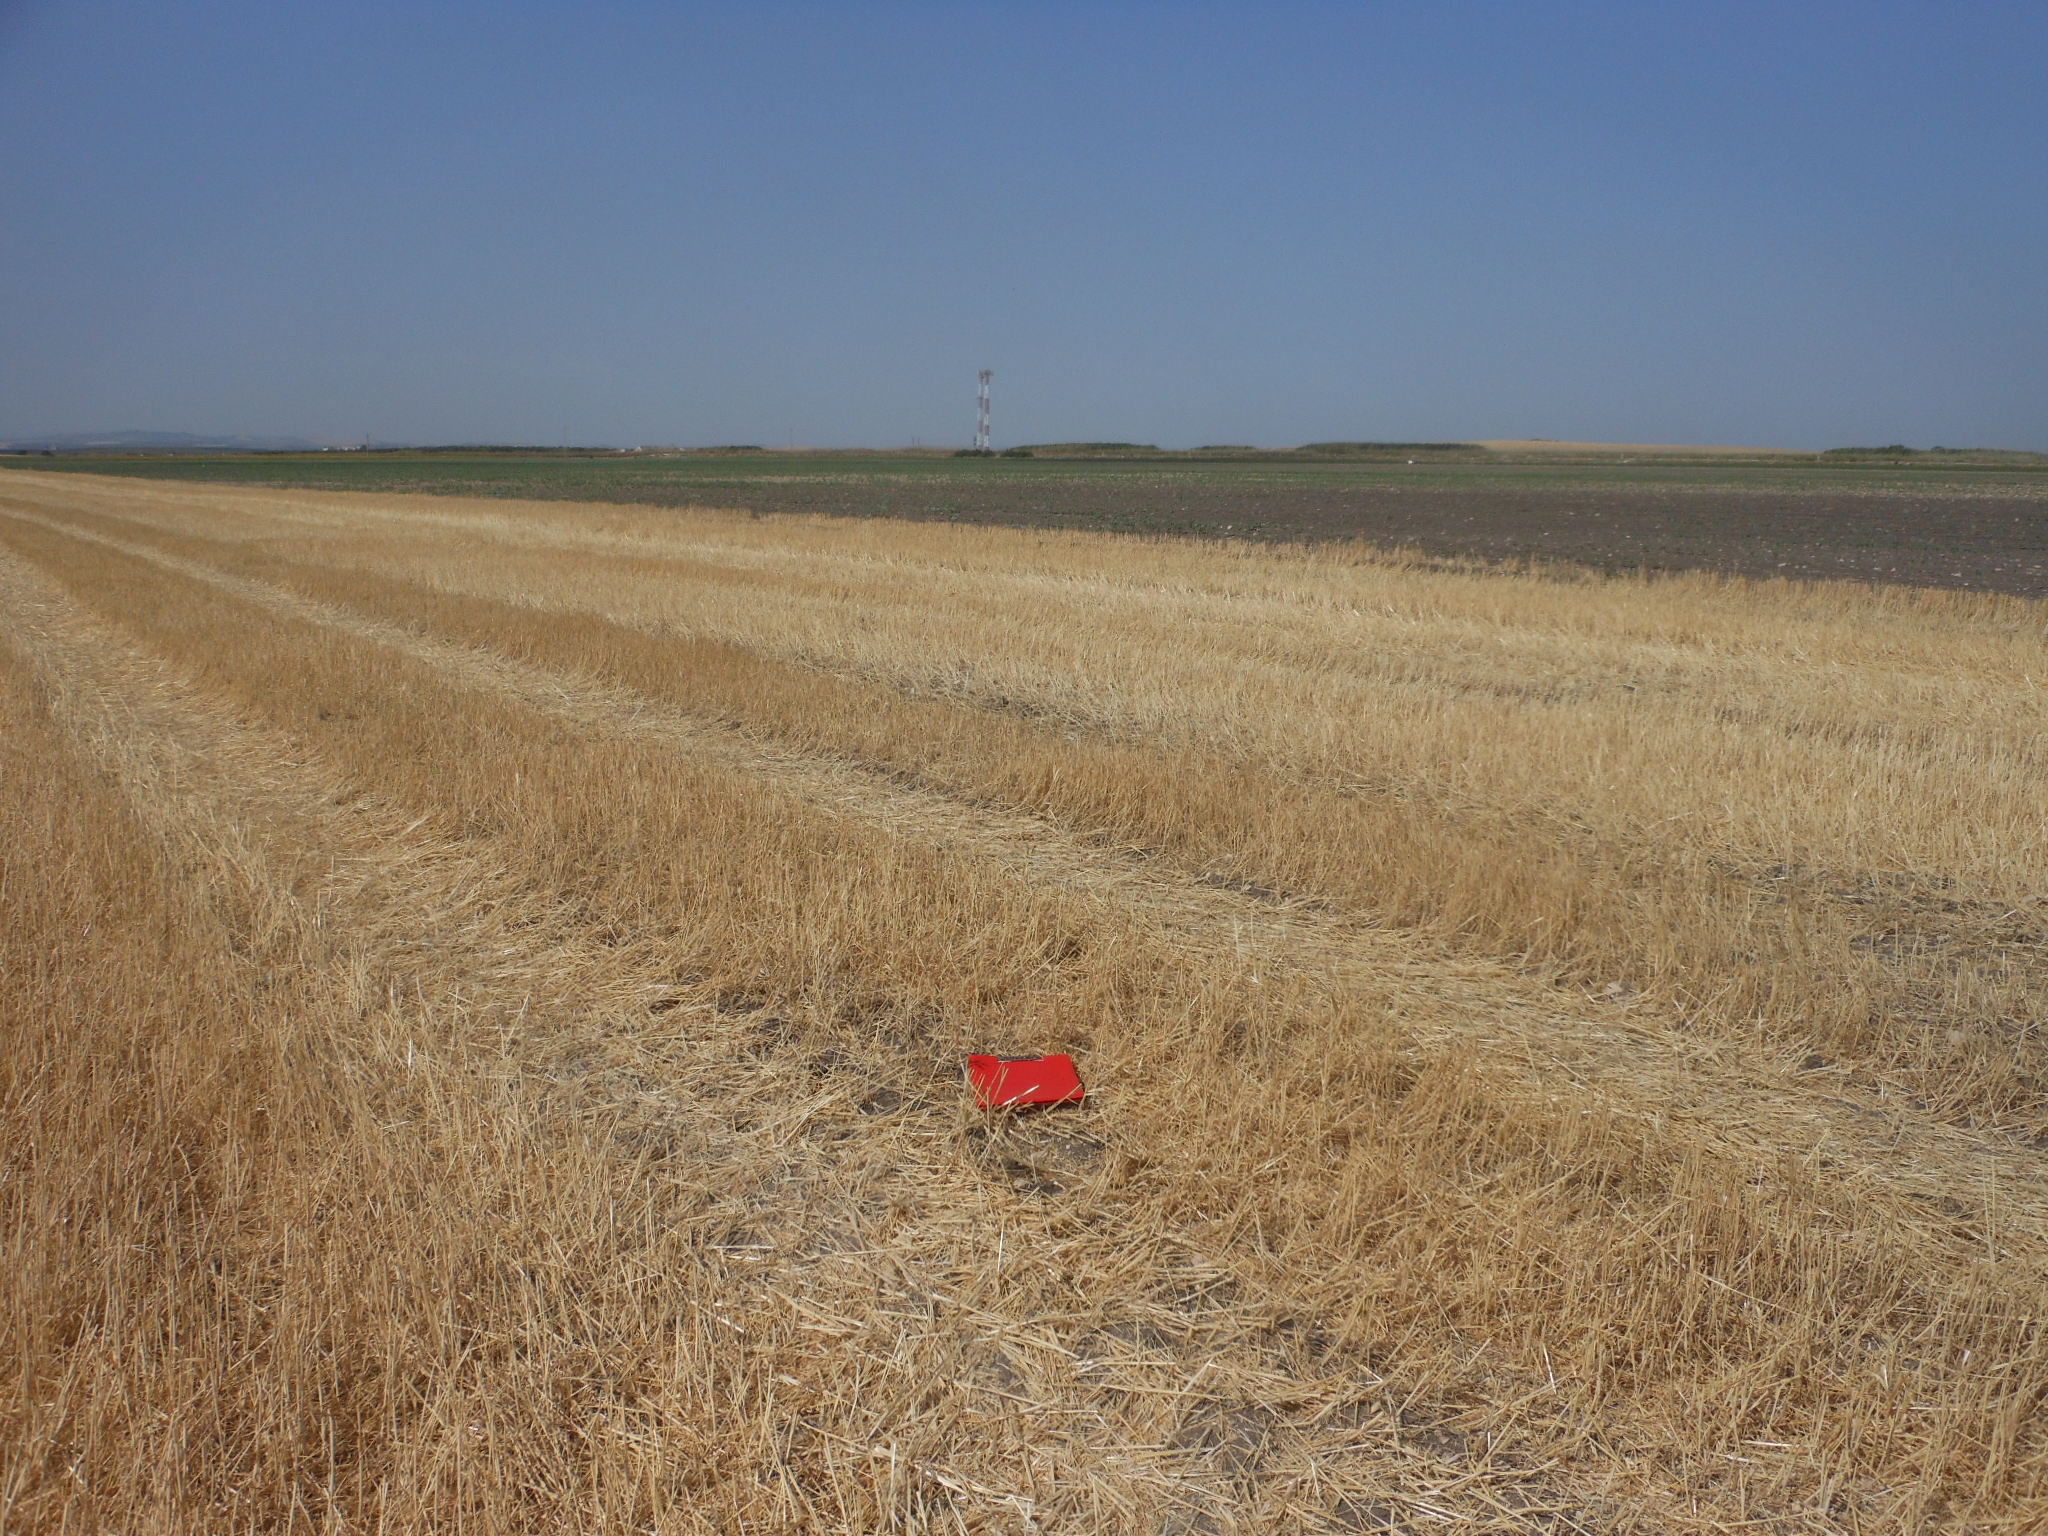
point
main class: Cropland
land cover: Common wheat
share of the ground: < 10 %
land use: Agriculture (excluding fallow land and kitchen gardens)
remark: Harvested field
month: June
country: ES
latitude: 37.3226
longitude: -5.1197
